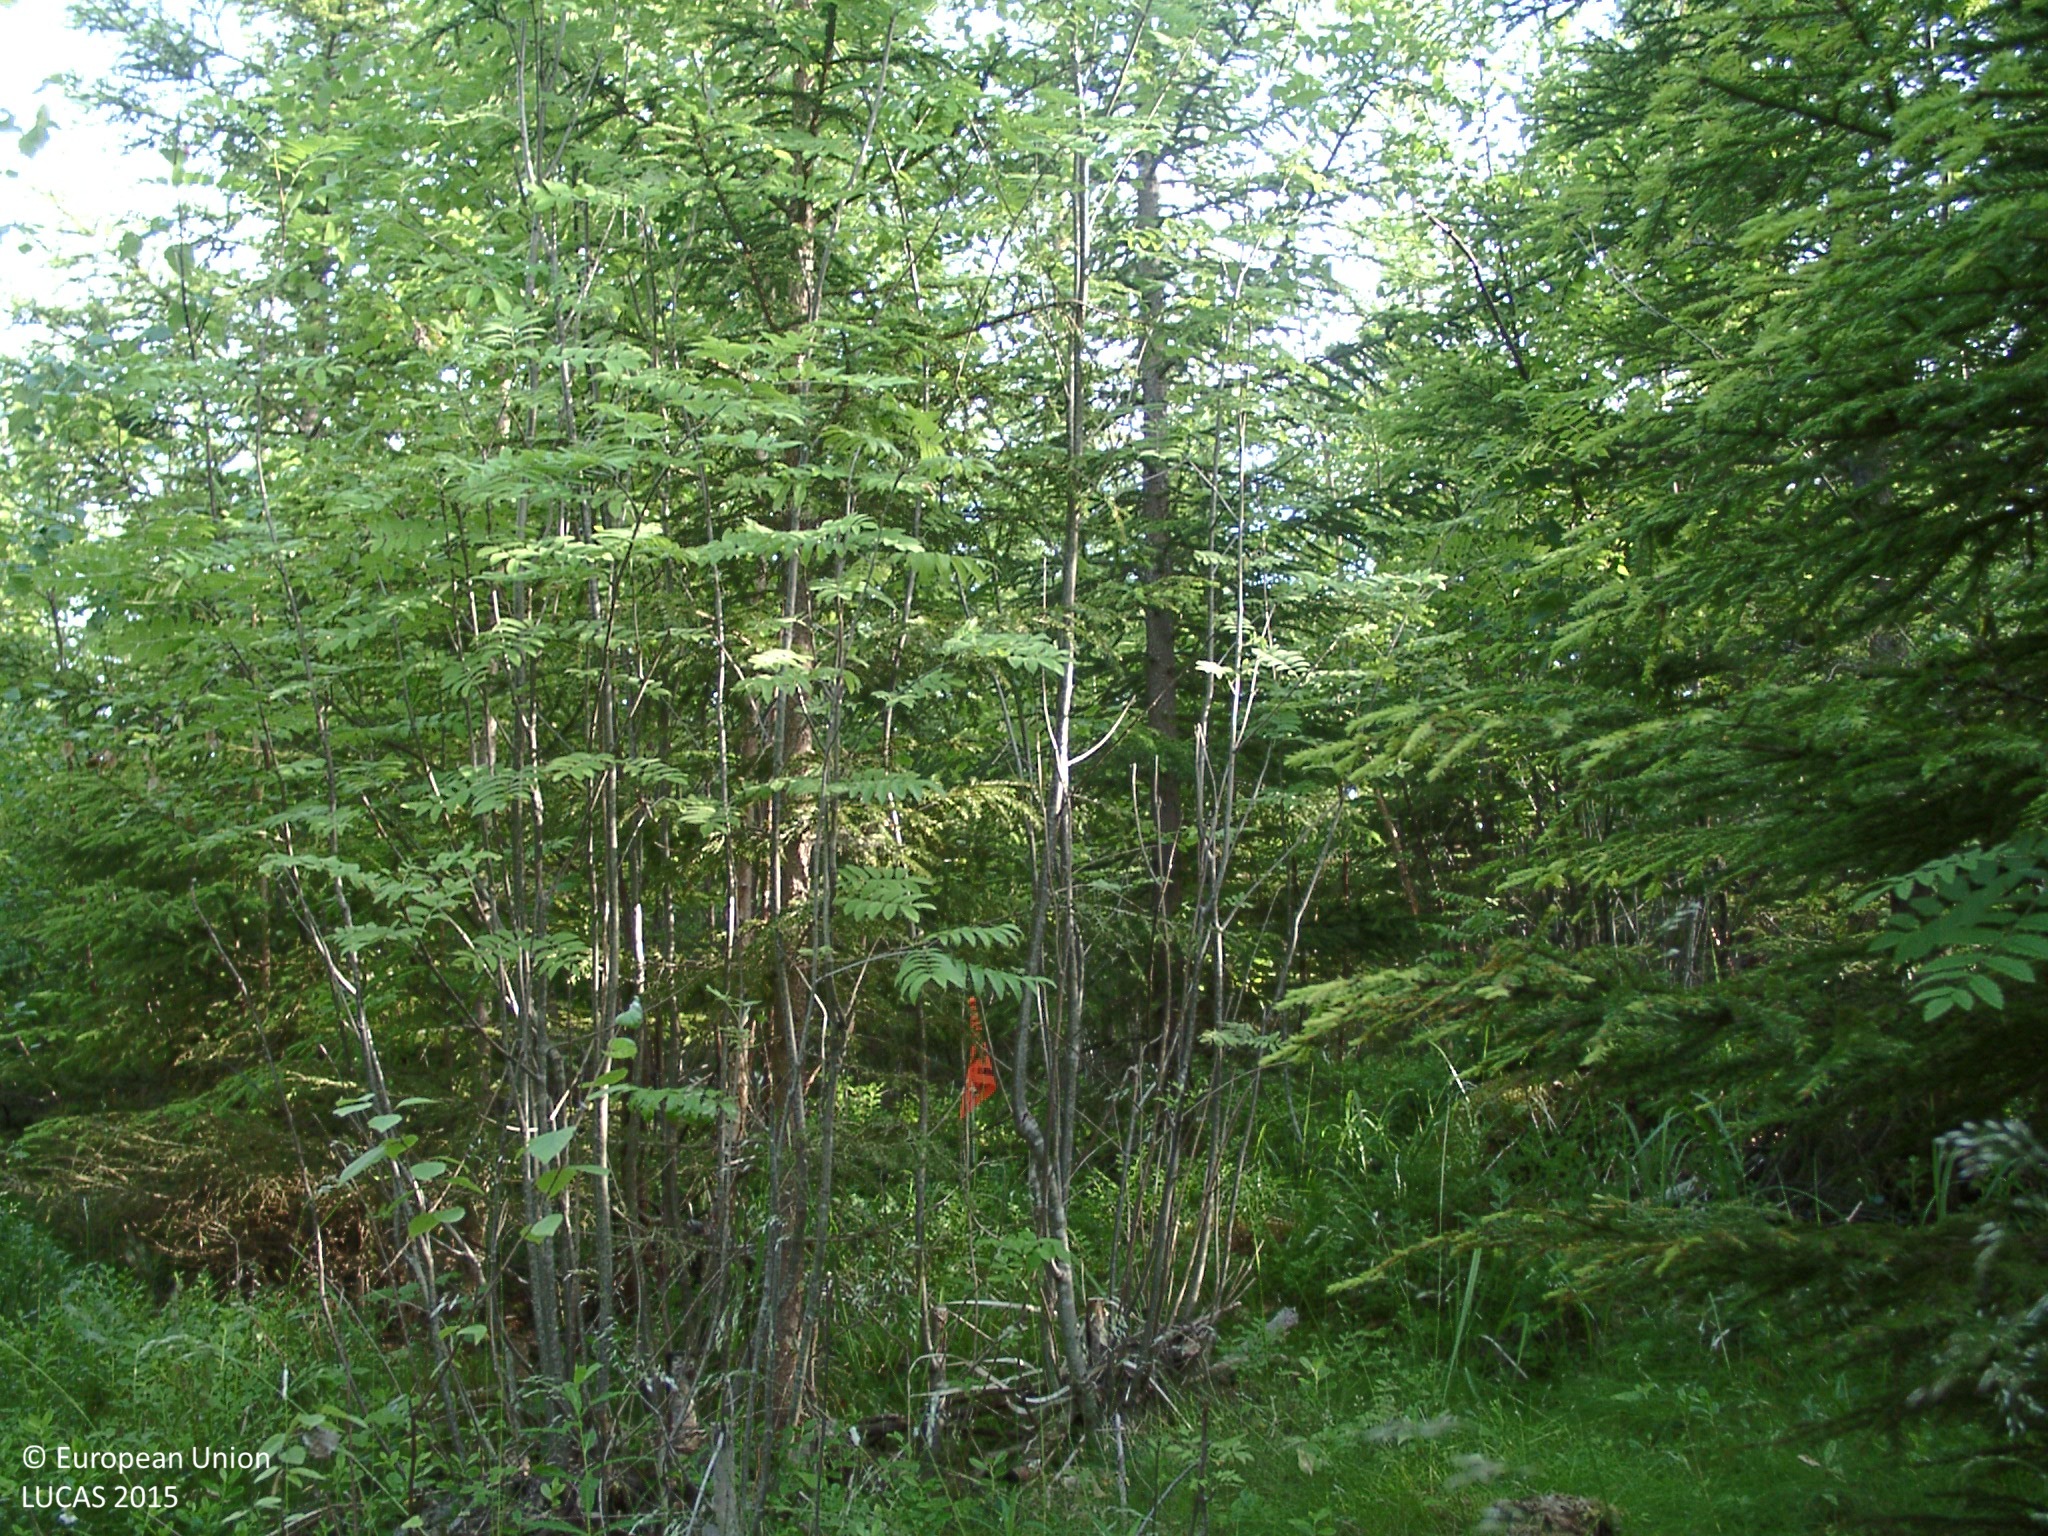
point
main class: Woodland
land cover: Spruce dominated mixed woodland
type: boreal forest
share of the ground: > 75 %
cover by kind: broadleaved forest trees 45 %, coniferous forest trees 40 %, shrubs 5 %, herbaceous plants 5 %, lichens and mosses 5 %
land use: Forestry
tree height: < 5 m
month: July
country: FI
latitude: 62.2456
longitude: 25.1392
